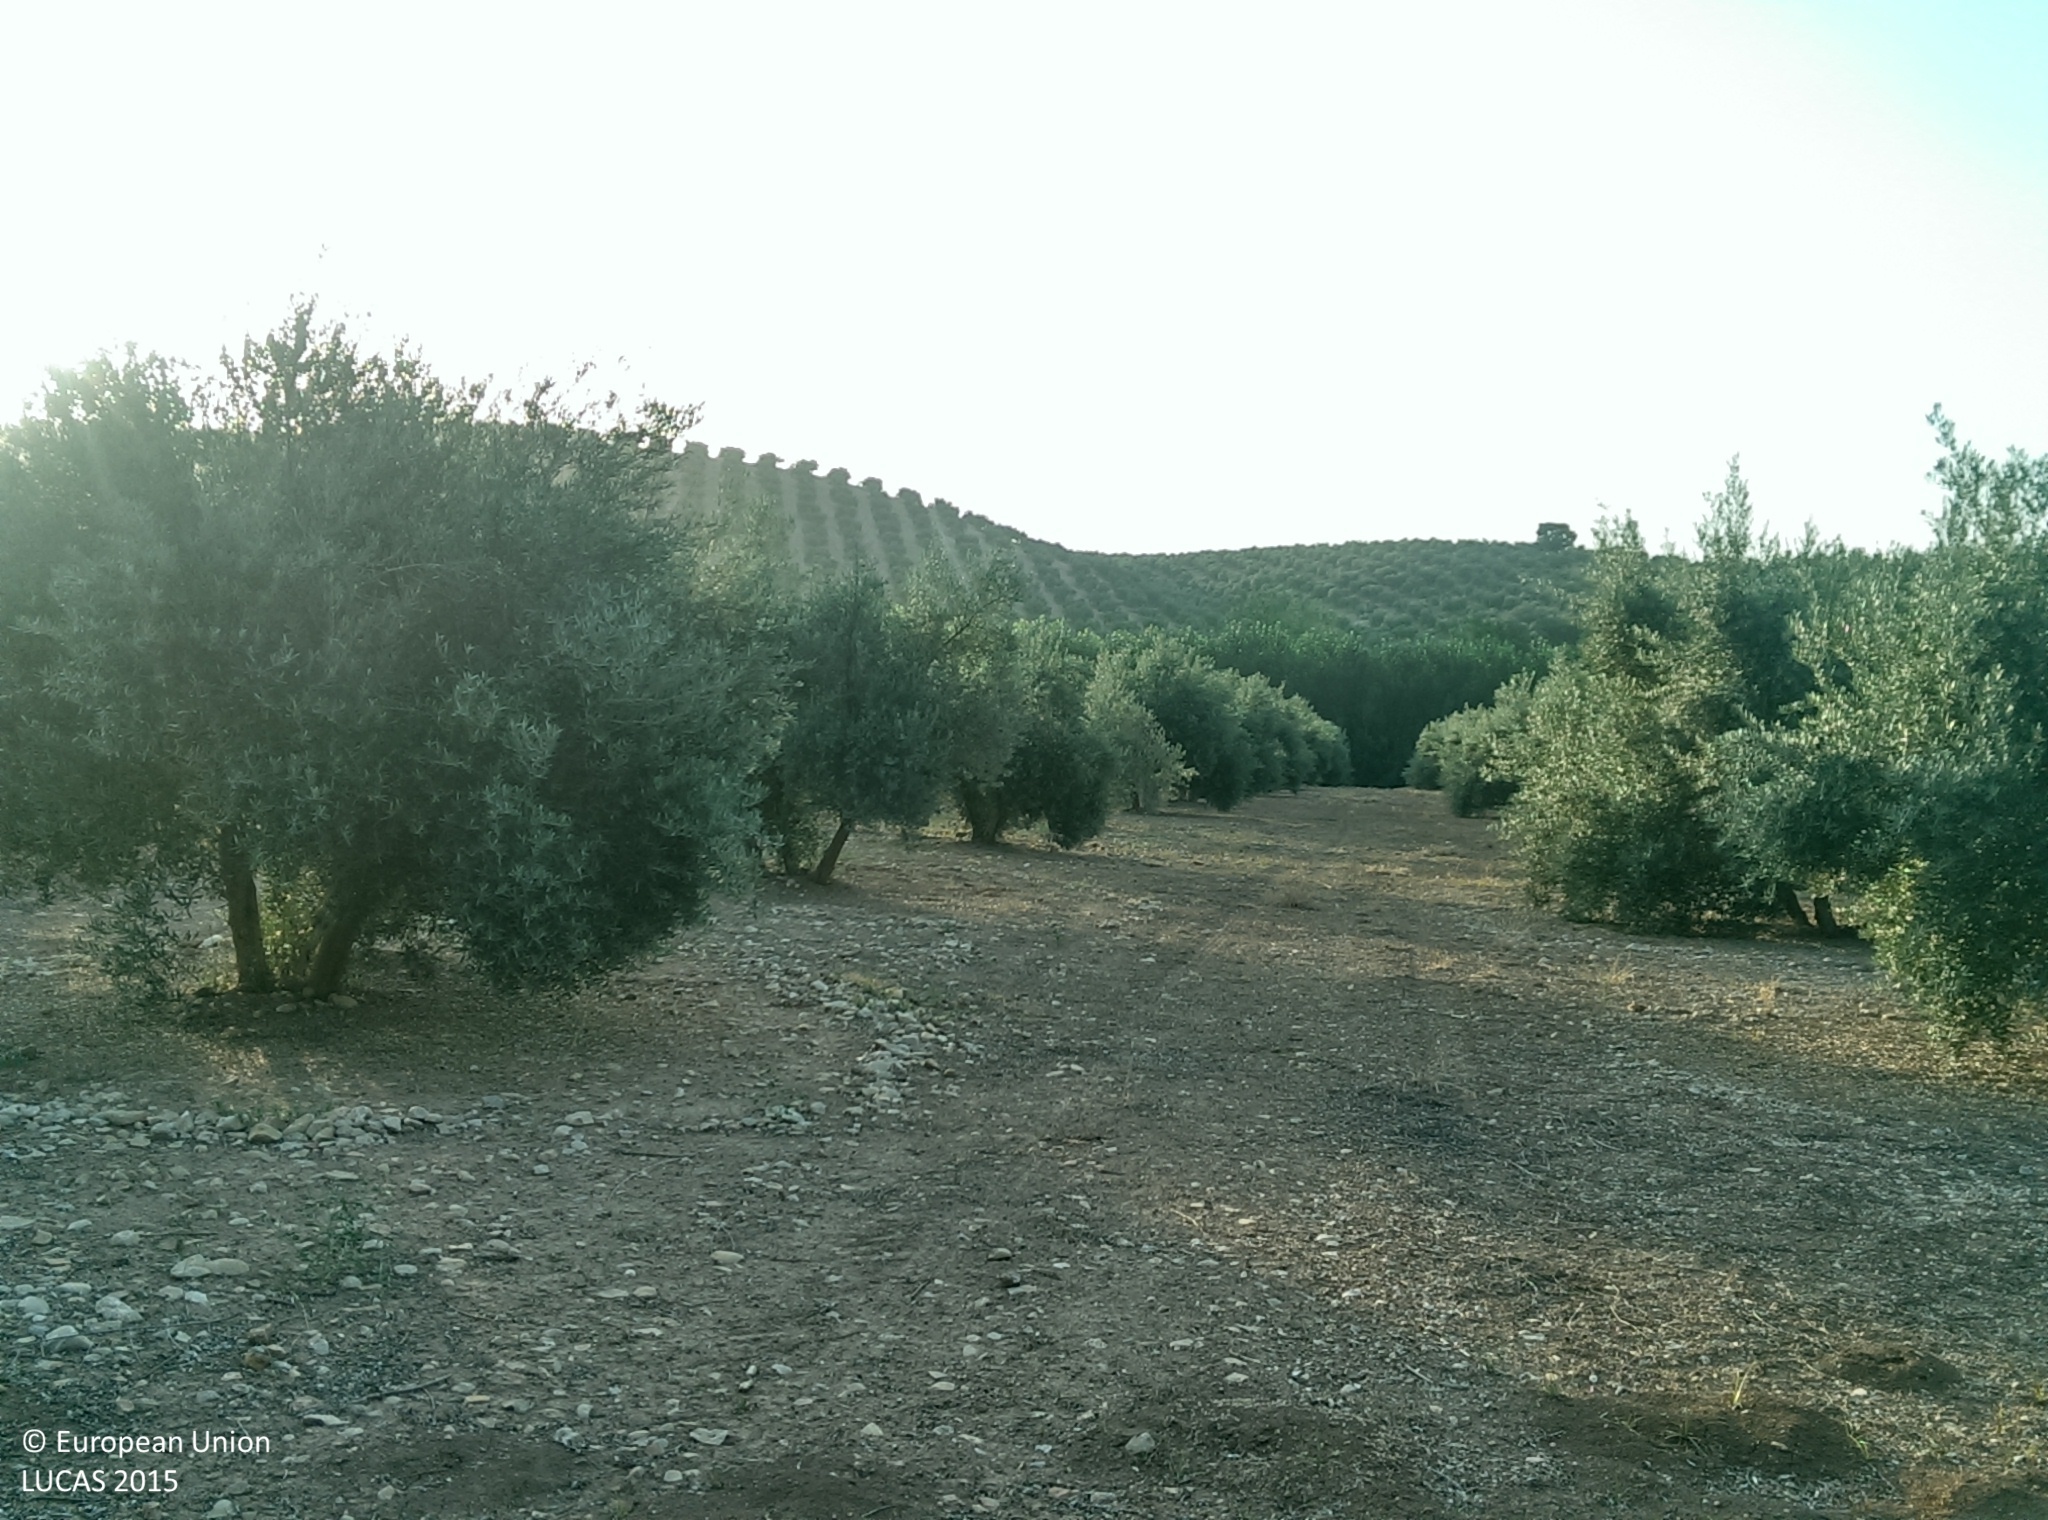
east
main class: Cropland
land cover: Olive groves
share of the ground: 50 - 75 %
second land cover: Other bare soil
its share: > 75 %
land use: Agriculture (excluding fallow land and kitchen gardens)
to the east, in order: Olive groves; Other bare soil; Grass margins; Broadleaved woodland; Grassland with sparse tree/shrub cover; Inland fresh running water; Grassland with sparse tree/shrub cover; Olive groves
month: July
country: ES
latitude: 37.3198
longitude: -3.7032
